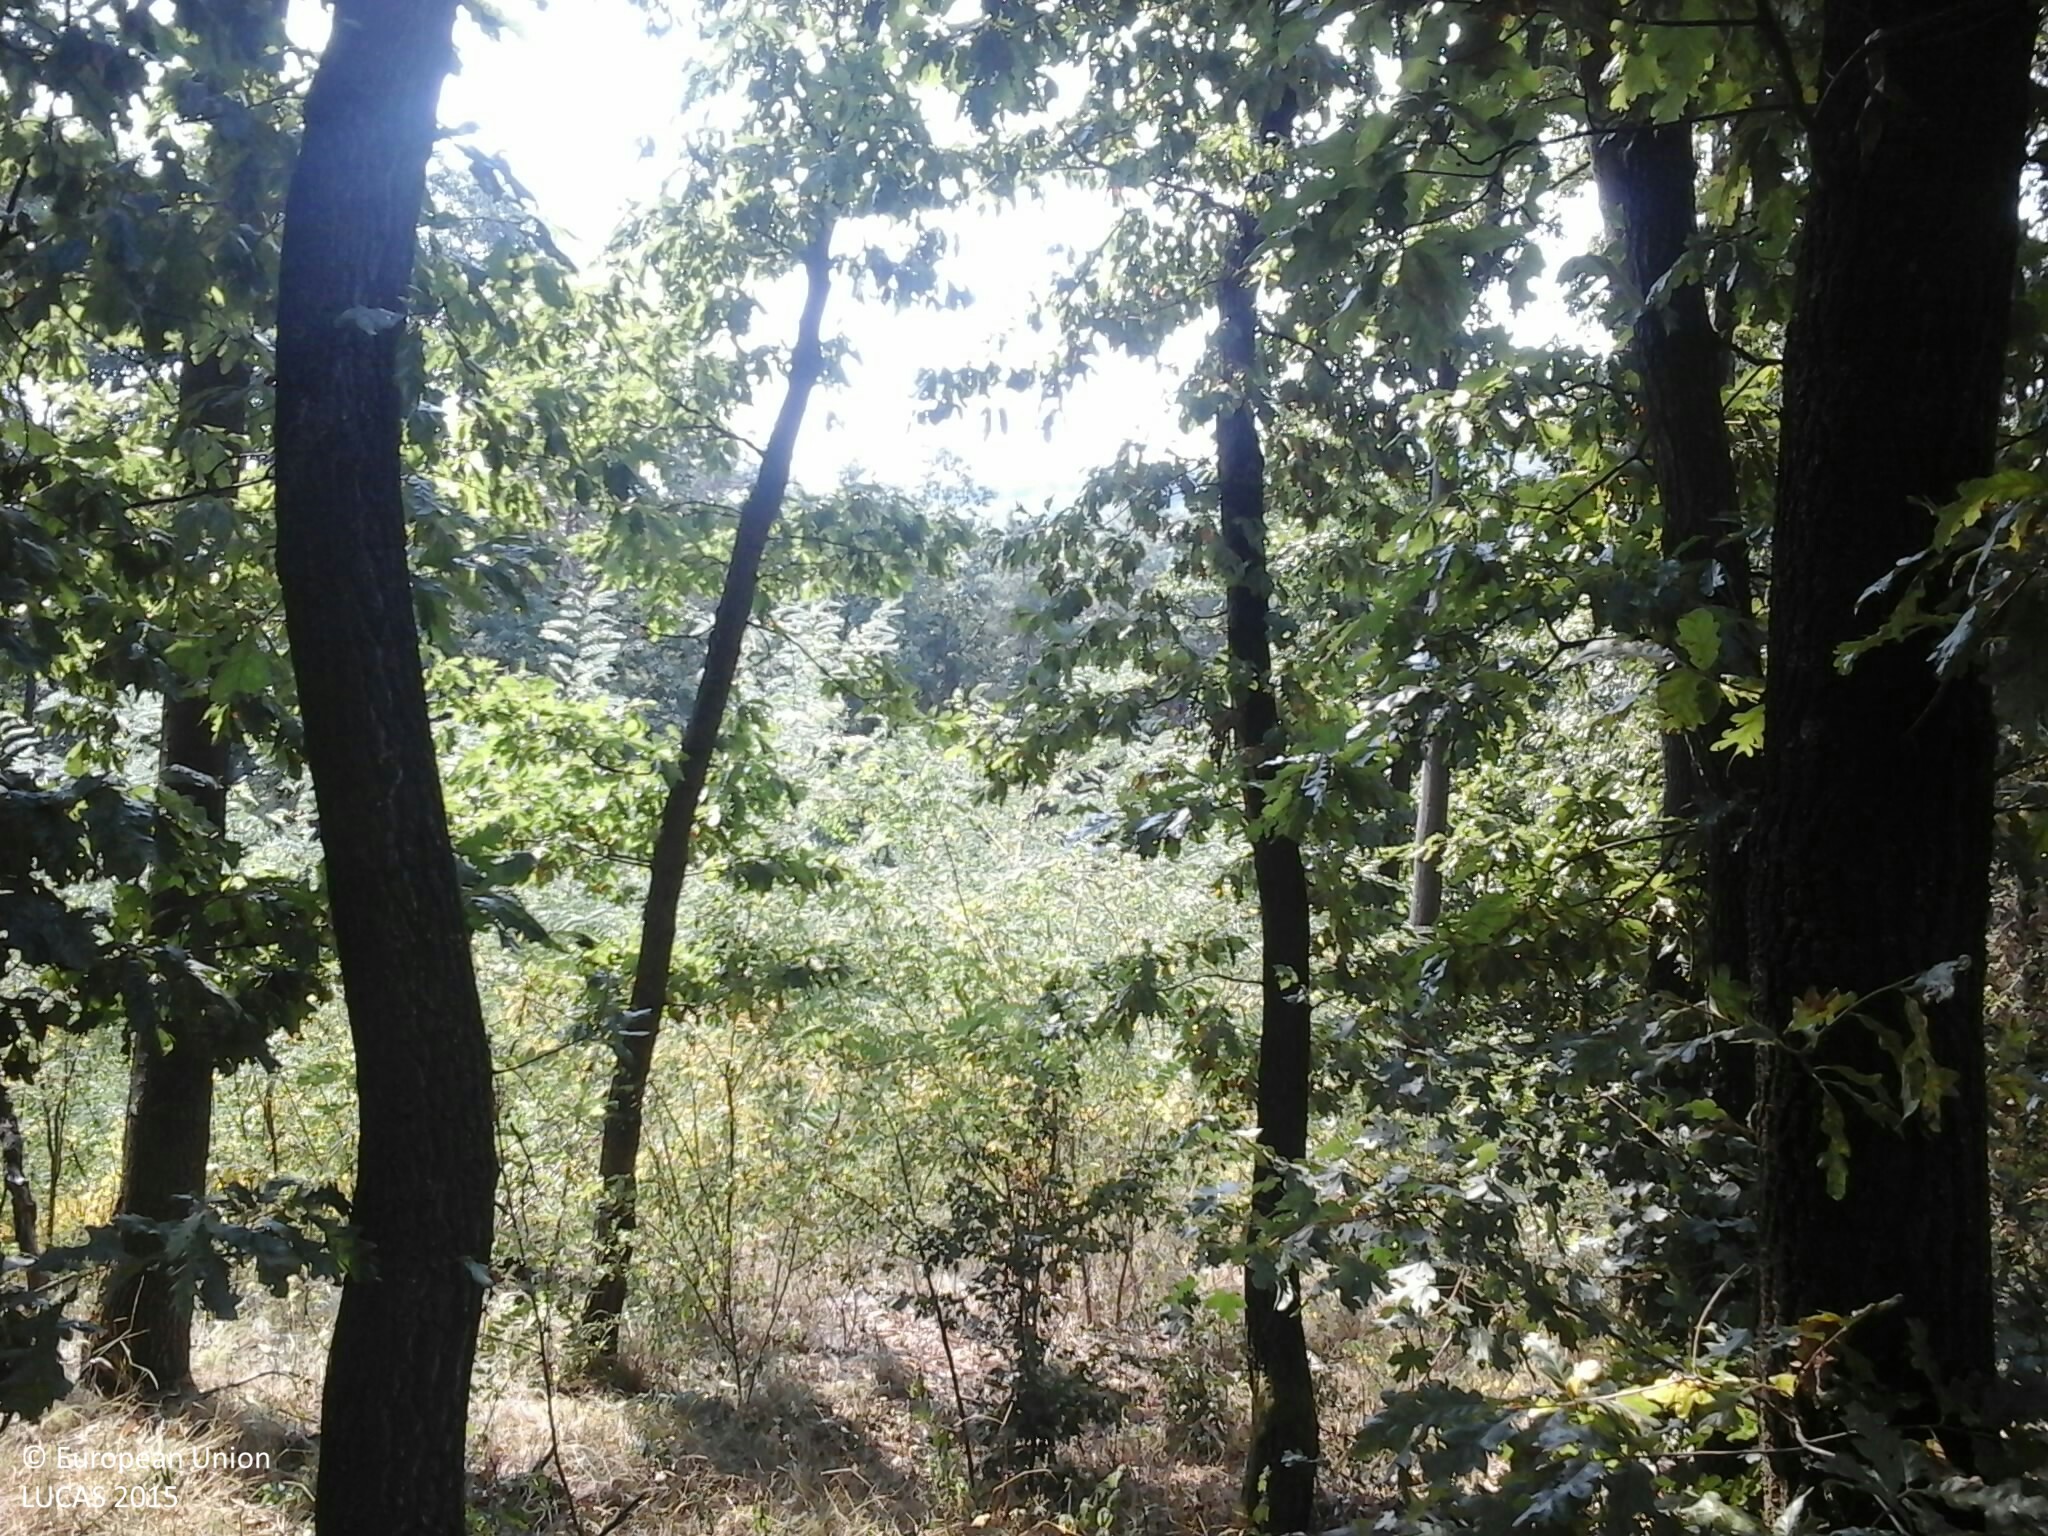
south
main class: Woodland
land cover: Broadleaved woodland
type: thermophilous deciduous forest
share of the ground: > 75 %
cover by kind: broadleaved forest trees 80 %, shrubs 15 %, herbaceous plants 5 %
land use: Forestry
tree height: > 5 m
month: August
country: HU
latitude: 47.9118
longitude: 19.1855
